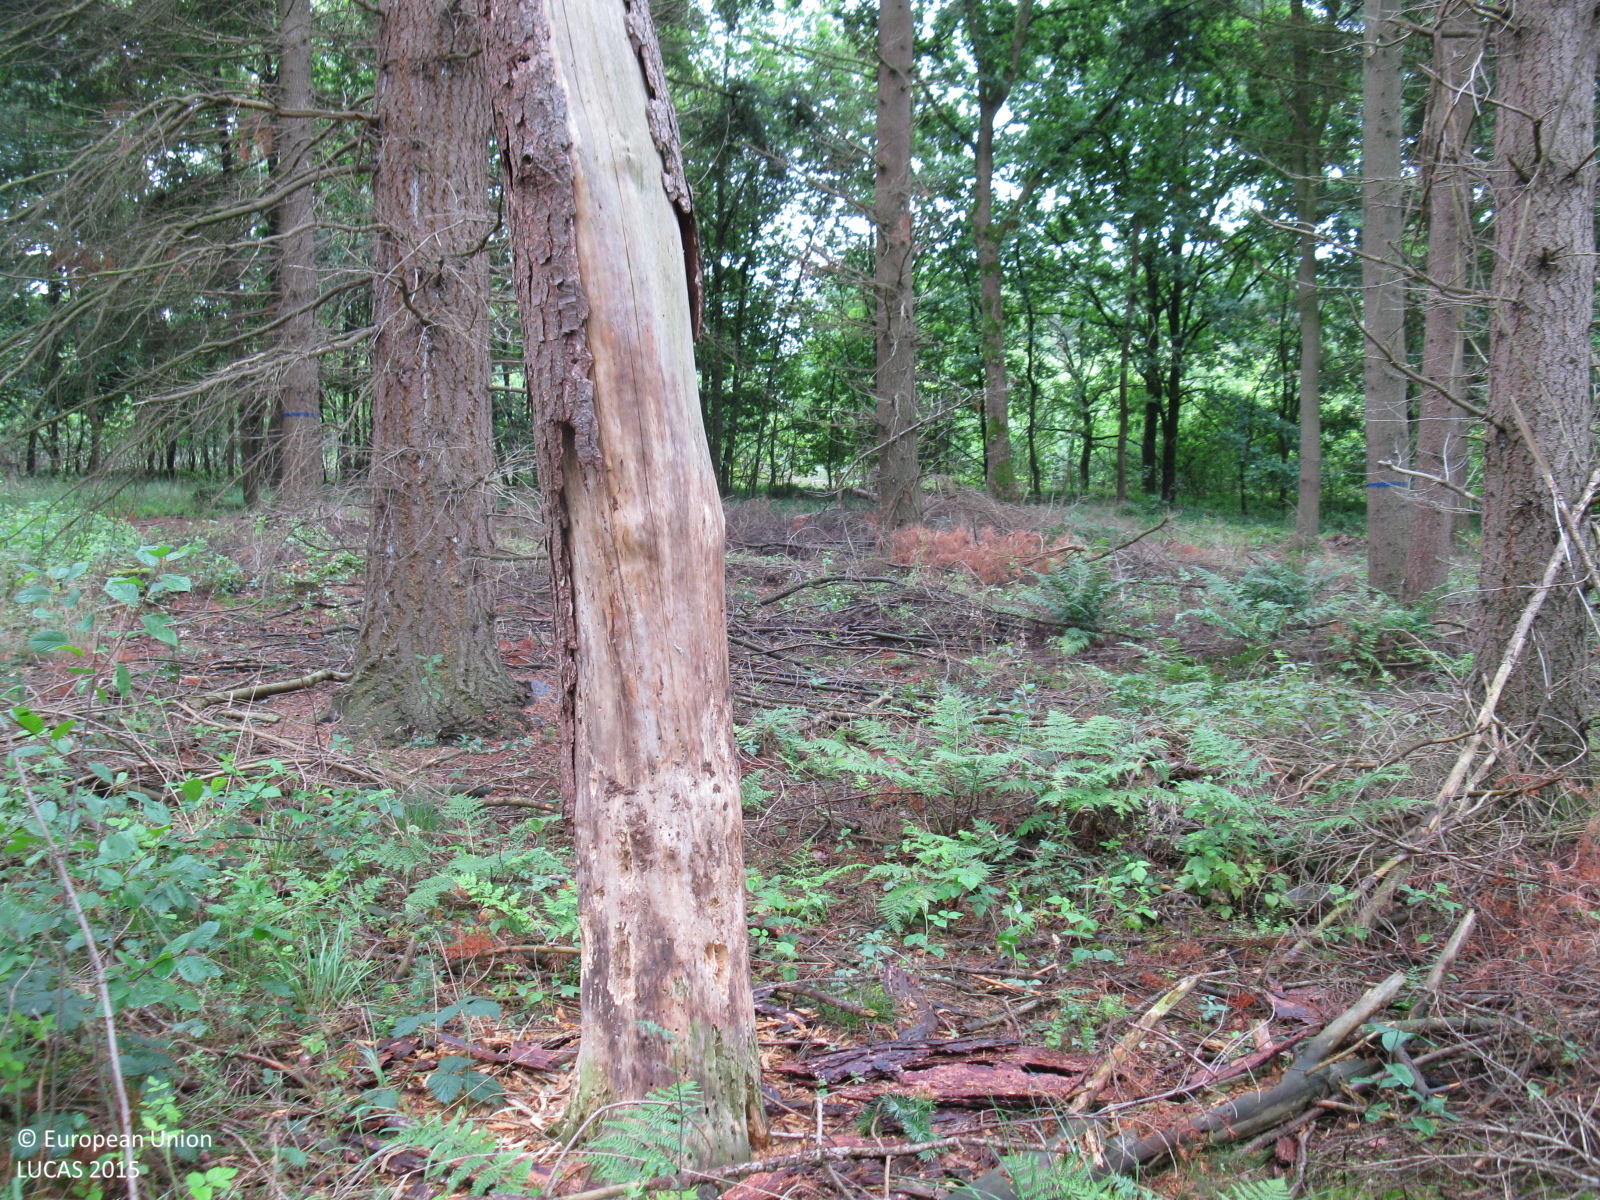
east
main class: Woodland
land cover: Other coniferous woodland
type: hemiboreal forest and nemoral coniferous forest and mixed broadleaved-coniferous forest
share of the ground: > 75 %
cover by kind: coniferous forest trees 85 %, herbaceous plants 10 %, shrubs 5 %
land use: Forestry
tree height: > 5 m
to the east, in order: Other coniferous woodland; Broadleaved woodland; Tracks; Broadleaved woodland; Fences; Broadleaved woodland
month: July
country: DE
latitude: 52.9256
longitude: 8.5279
